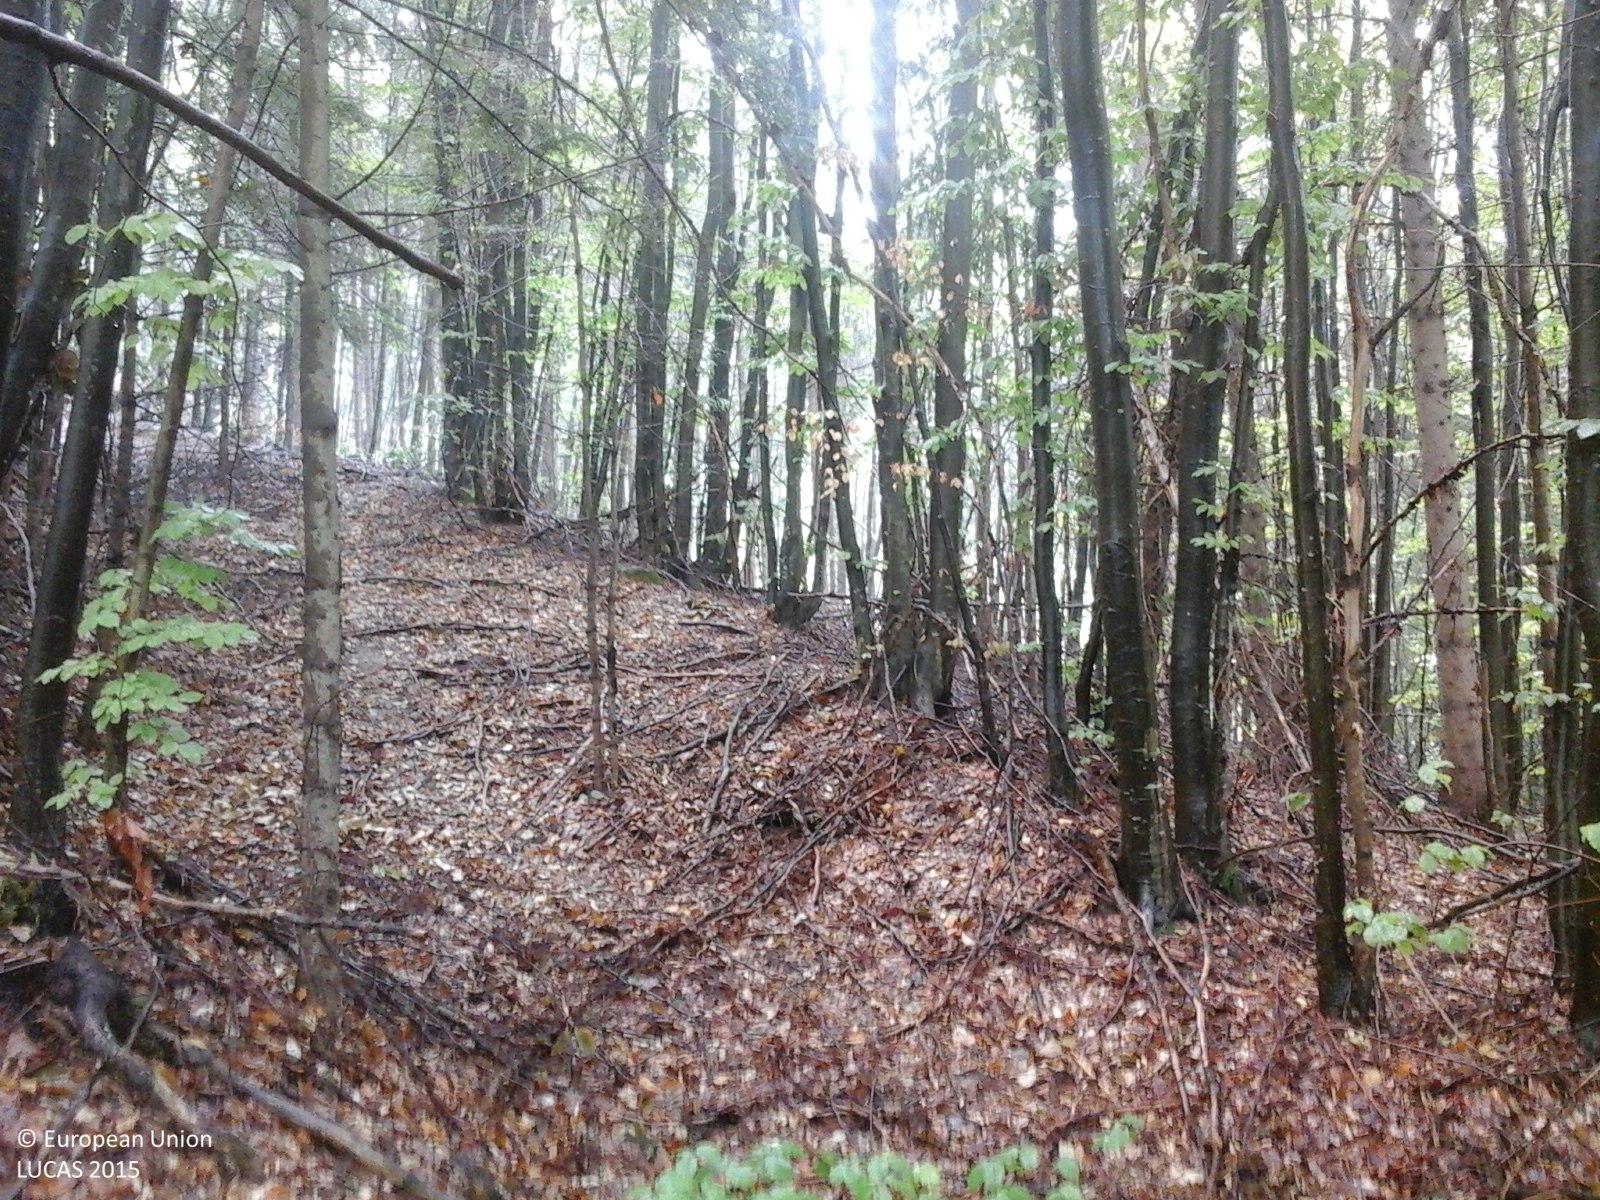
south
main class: Woodland
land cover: Other mixed woodland
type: mountainous beech forest
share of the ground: > 75 %
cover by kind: broadleaved forest trees 75 %, coniferous forest trees 25 %
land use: Forestry
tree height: > 5 m
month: September
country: RO
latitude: 47.5940
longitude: 24.0350
